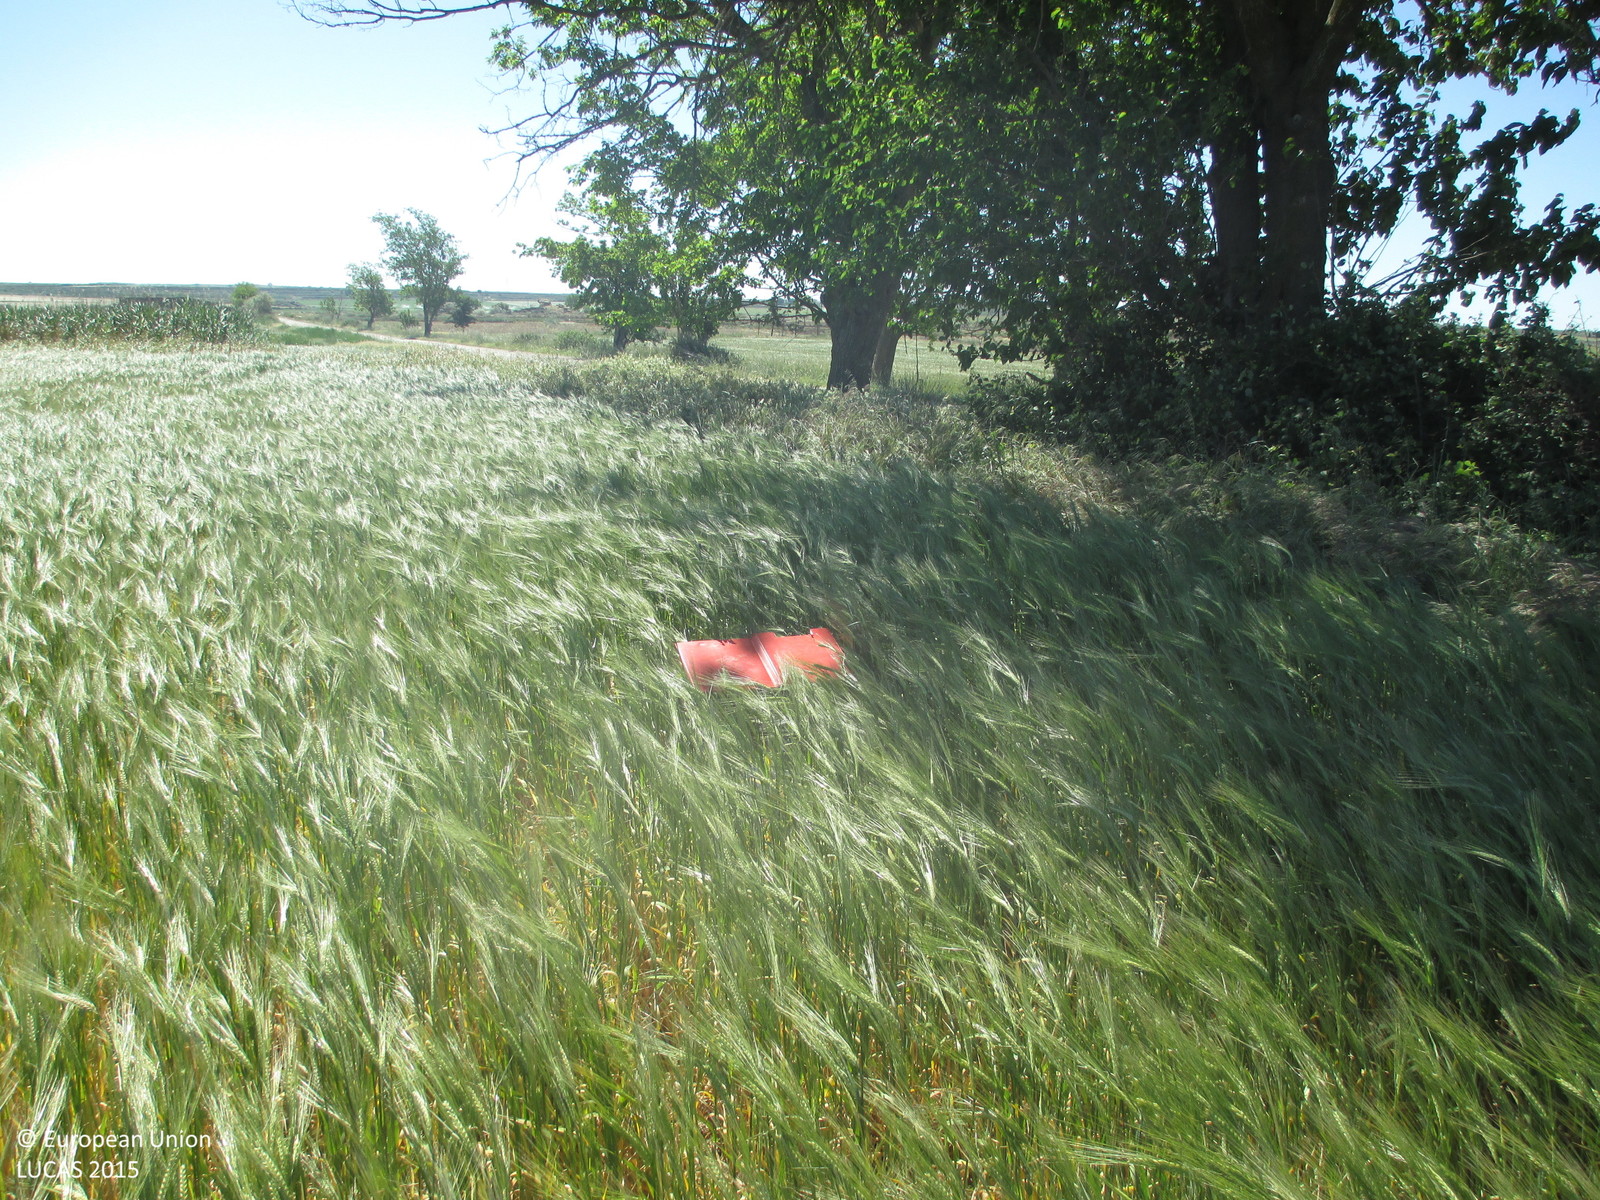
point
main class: Cropland
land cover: Barley
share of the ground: > 75 %
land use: Agriculture (excluding fallow land and kitchen gardens)
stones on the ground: < 10 %
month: May
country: ES
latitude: 41.8675
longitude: -0.1750
